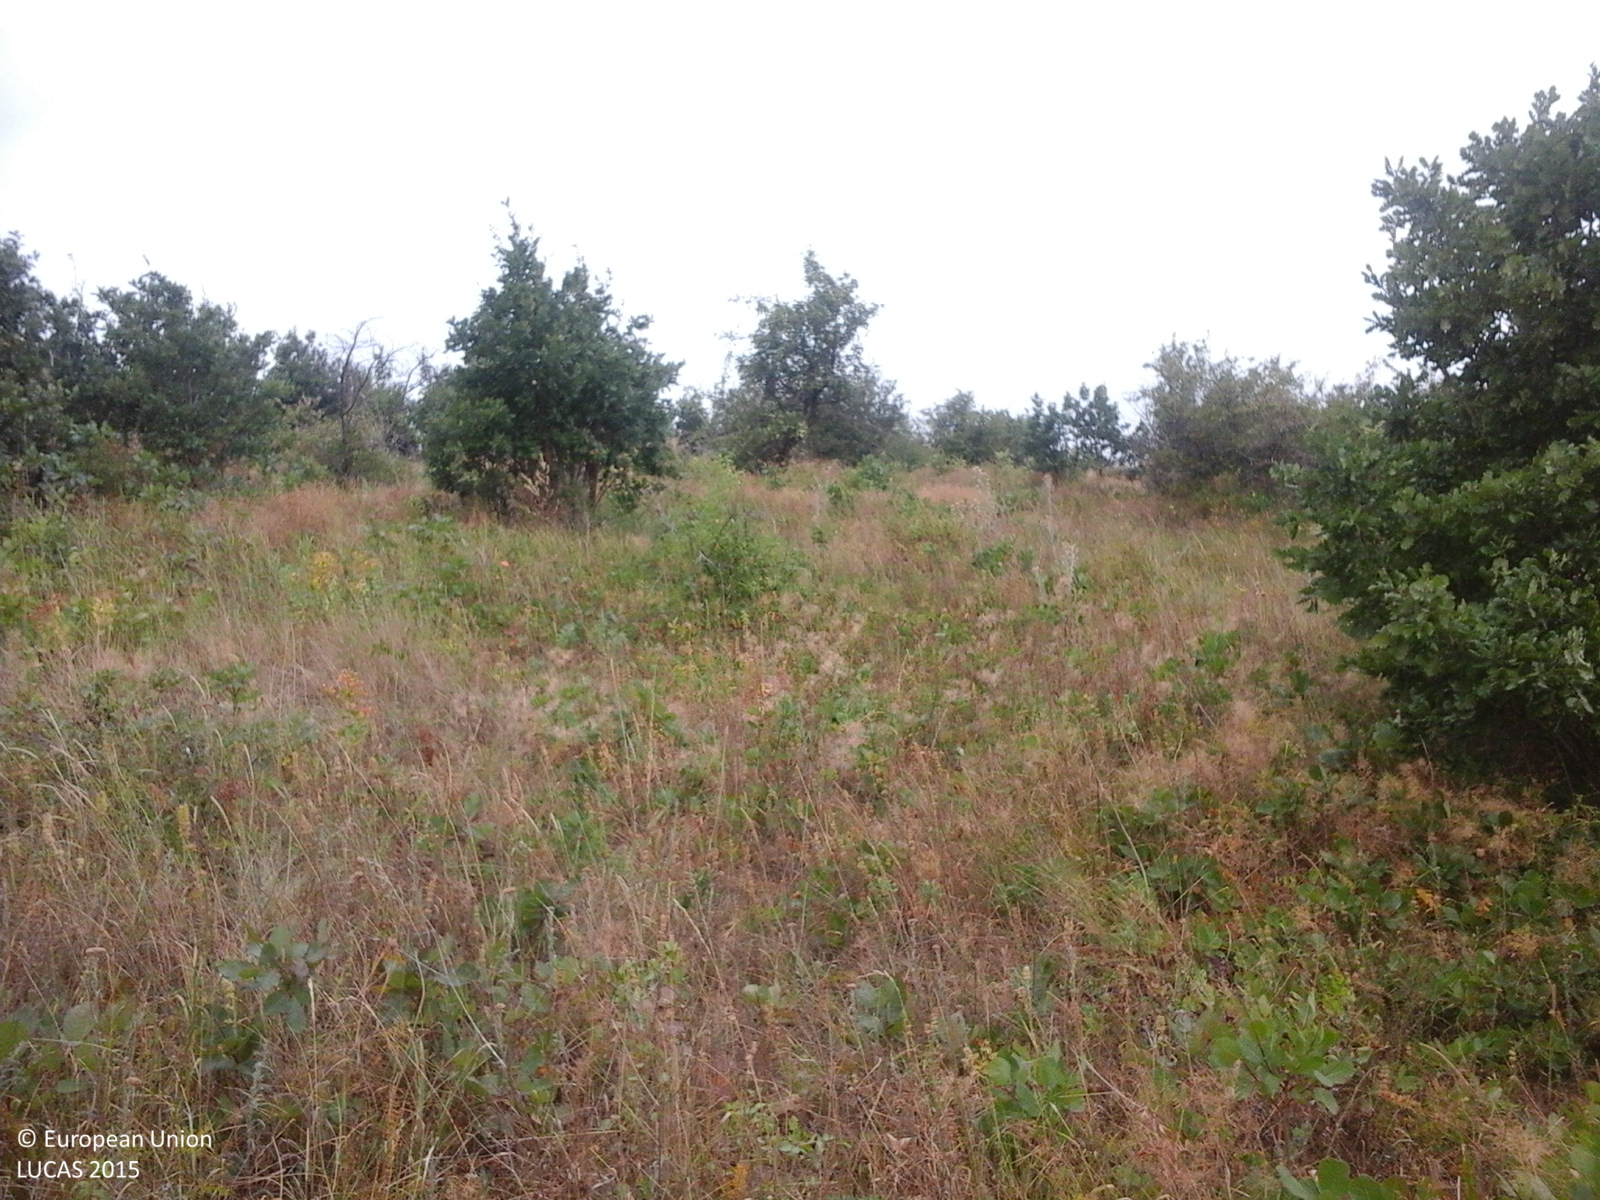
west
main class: Shrubland
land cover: Shrubland with sparse tree cover
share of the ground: > 75 %
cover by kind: shrubs 75 %, herbaceous plants 20 %, broadleaved forest trees 5 %
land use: Agriculture (excluding fallow land and kitchen gardens)
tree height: > 5 m
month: August
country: RO
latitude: 44.8935
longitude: 28.6581
